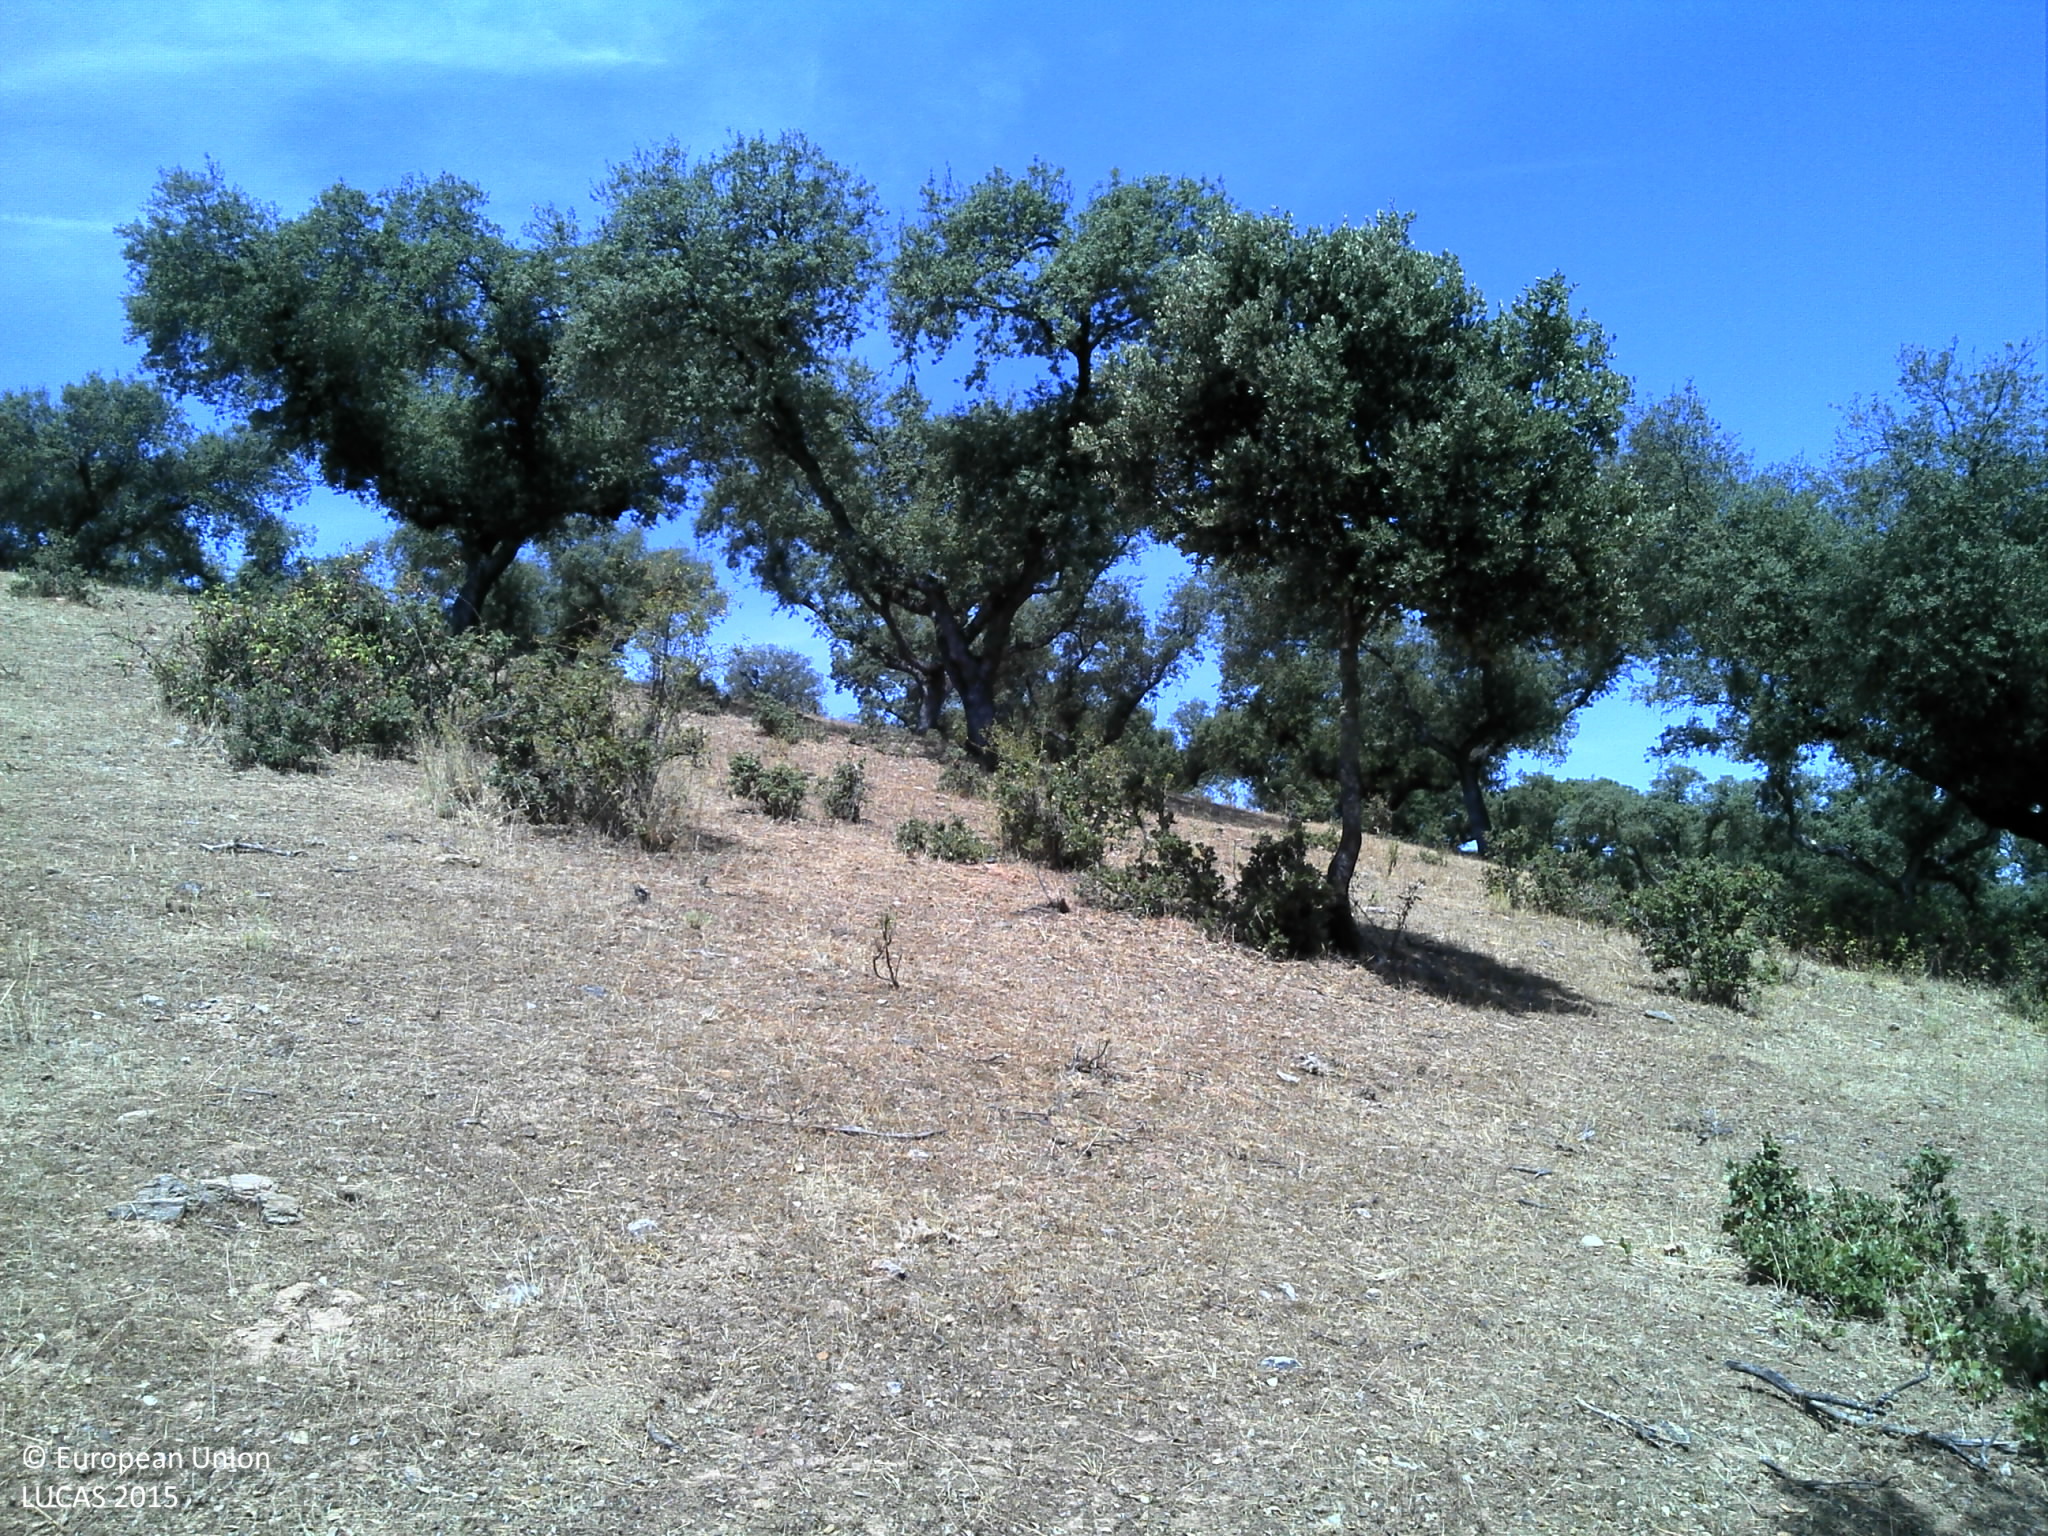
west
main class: Woodland
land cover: Broadleaved woodland
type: broadleaved evergreen forest
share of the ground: 25 - 50 %
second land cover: Grassland without tree/shrub cover
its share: 10 - 25 %
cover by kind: unconsolidated bare surface 55 %, broadleaved forest trees 30 %, herbaceous plants 15 %
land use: Forestry
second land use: Agriculture (excluding fallow land and kitchen gardens)
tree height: > 5 m
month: July
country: PT
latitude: 38.4953
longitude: -7.7017
